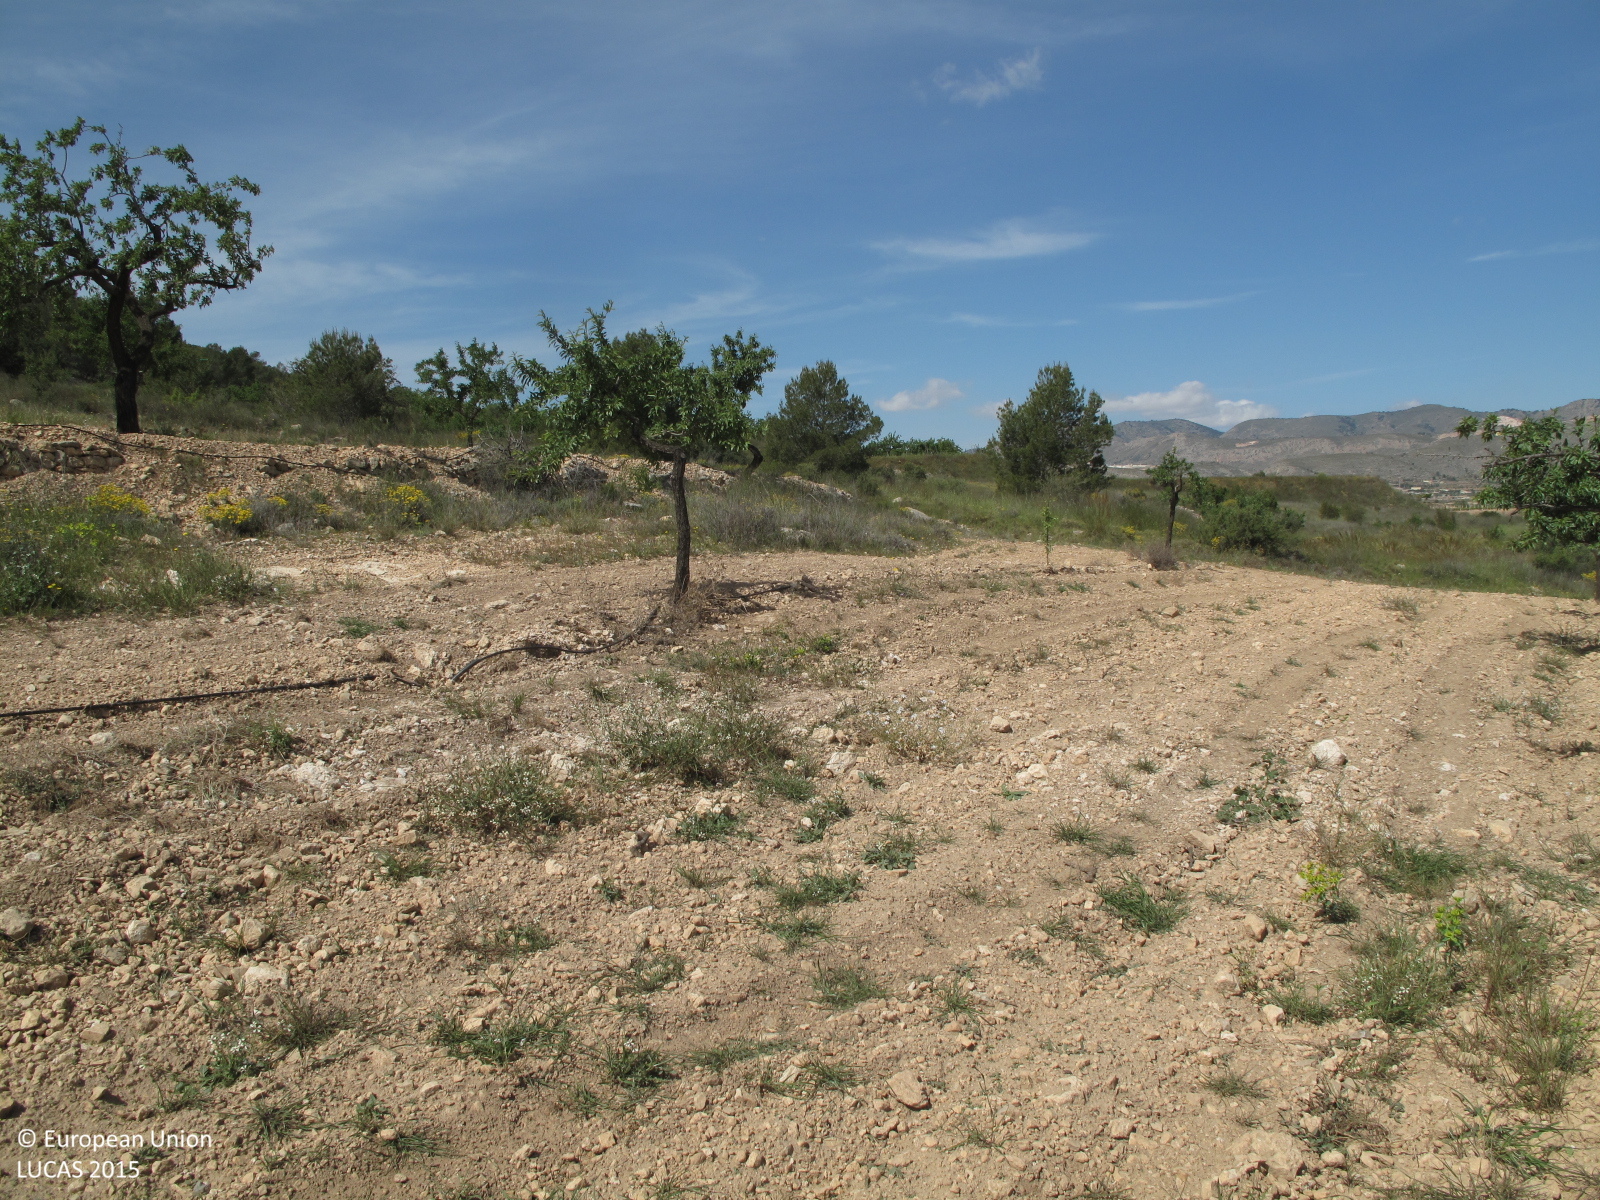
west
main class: Cropland
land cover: Nuts trees
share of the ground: < 10 %
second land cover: Other bare soil
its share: > 75 %
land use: Agriculture (excluding fallow land and kitchen gardens)
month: April
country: ES
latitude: 38.3473
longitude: -0.8685
